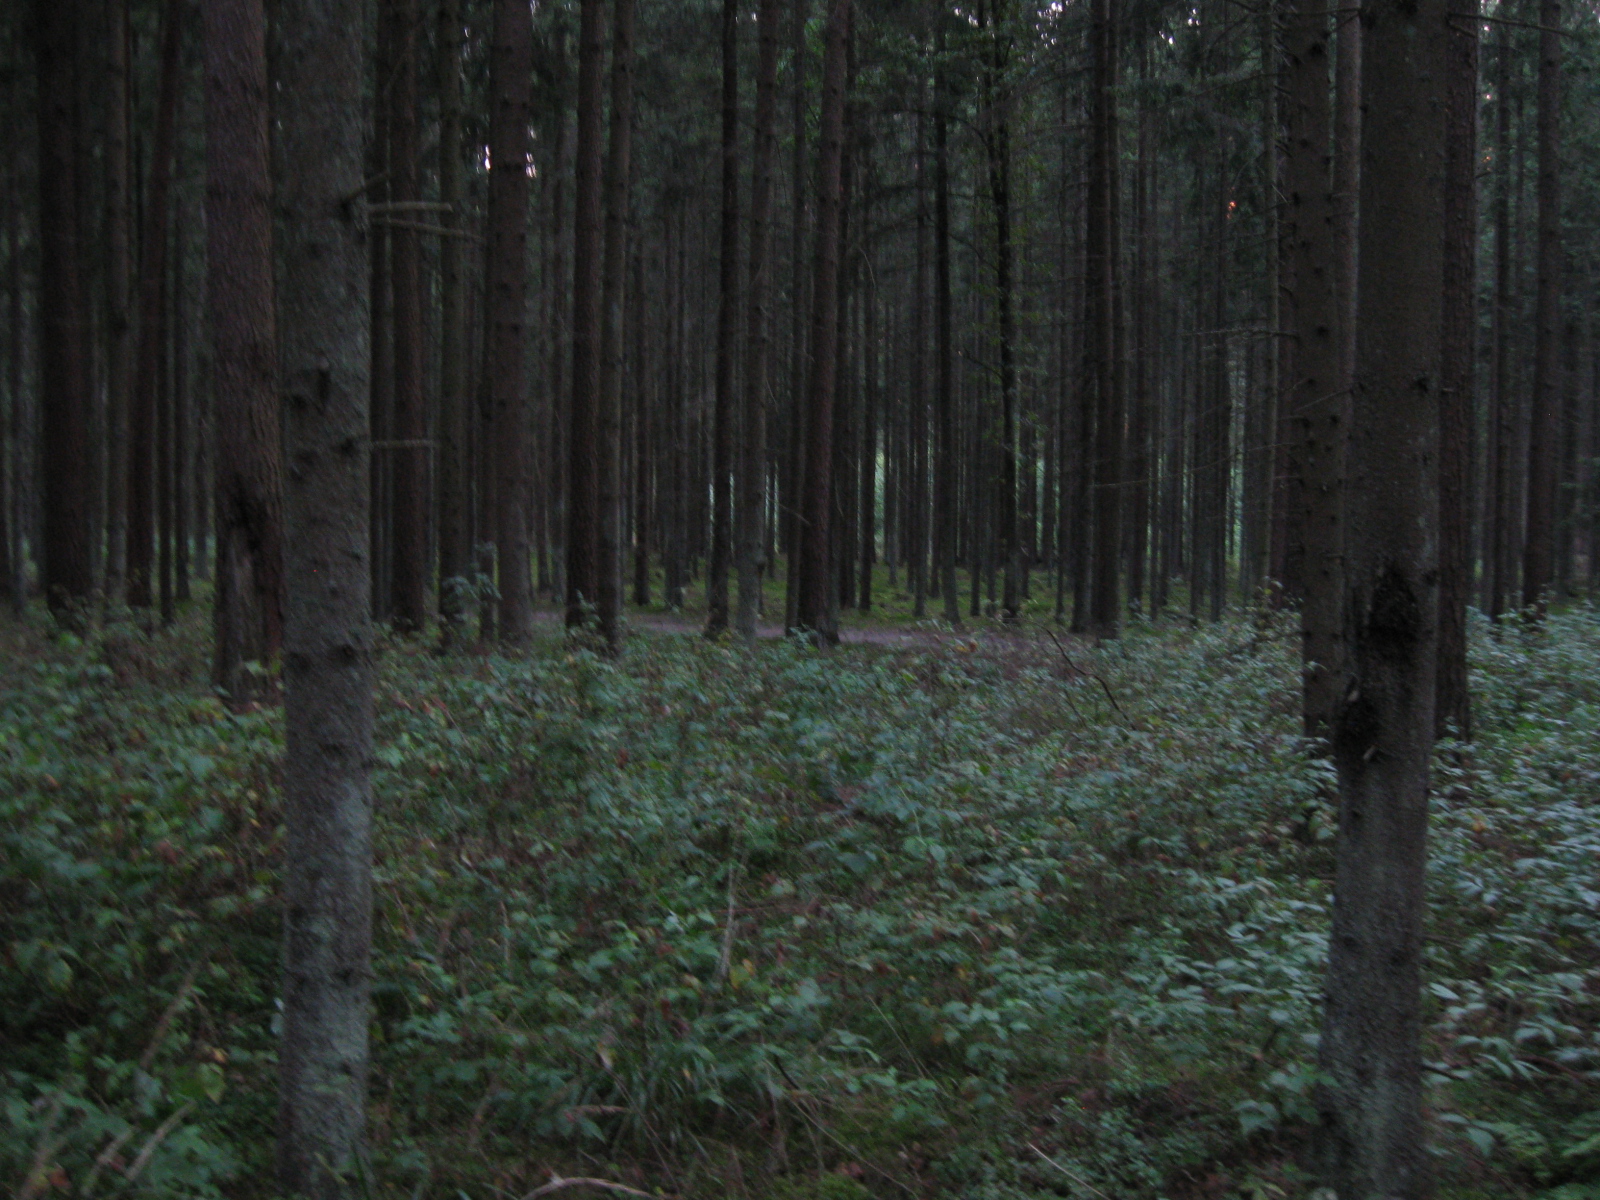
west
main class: Woodland
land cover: Pine dominated coniferous woodland
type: hemiboreal forest and nemoral coniferous forest and mixed broadleaved-coniferous forest
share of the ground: > 75 %
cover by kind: coniferous forest trees 75 %, herbaceous plants 10 %, lichens and mosses 10 %, shrubs 5 %
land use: Forestry
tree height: > 5 m
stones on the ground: < 10 %
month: August
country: LT
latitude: 54.6960
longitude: 23.5659
